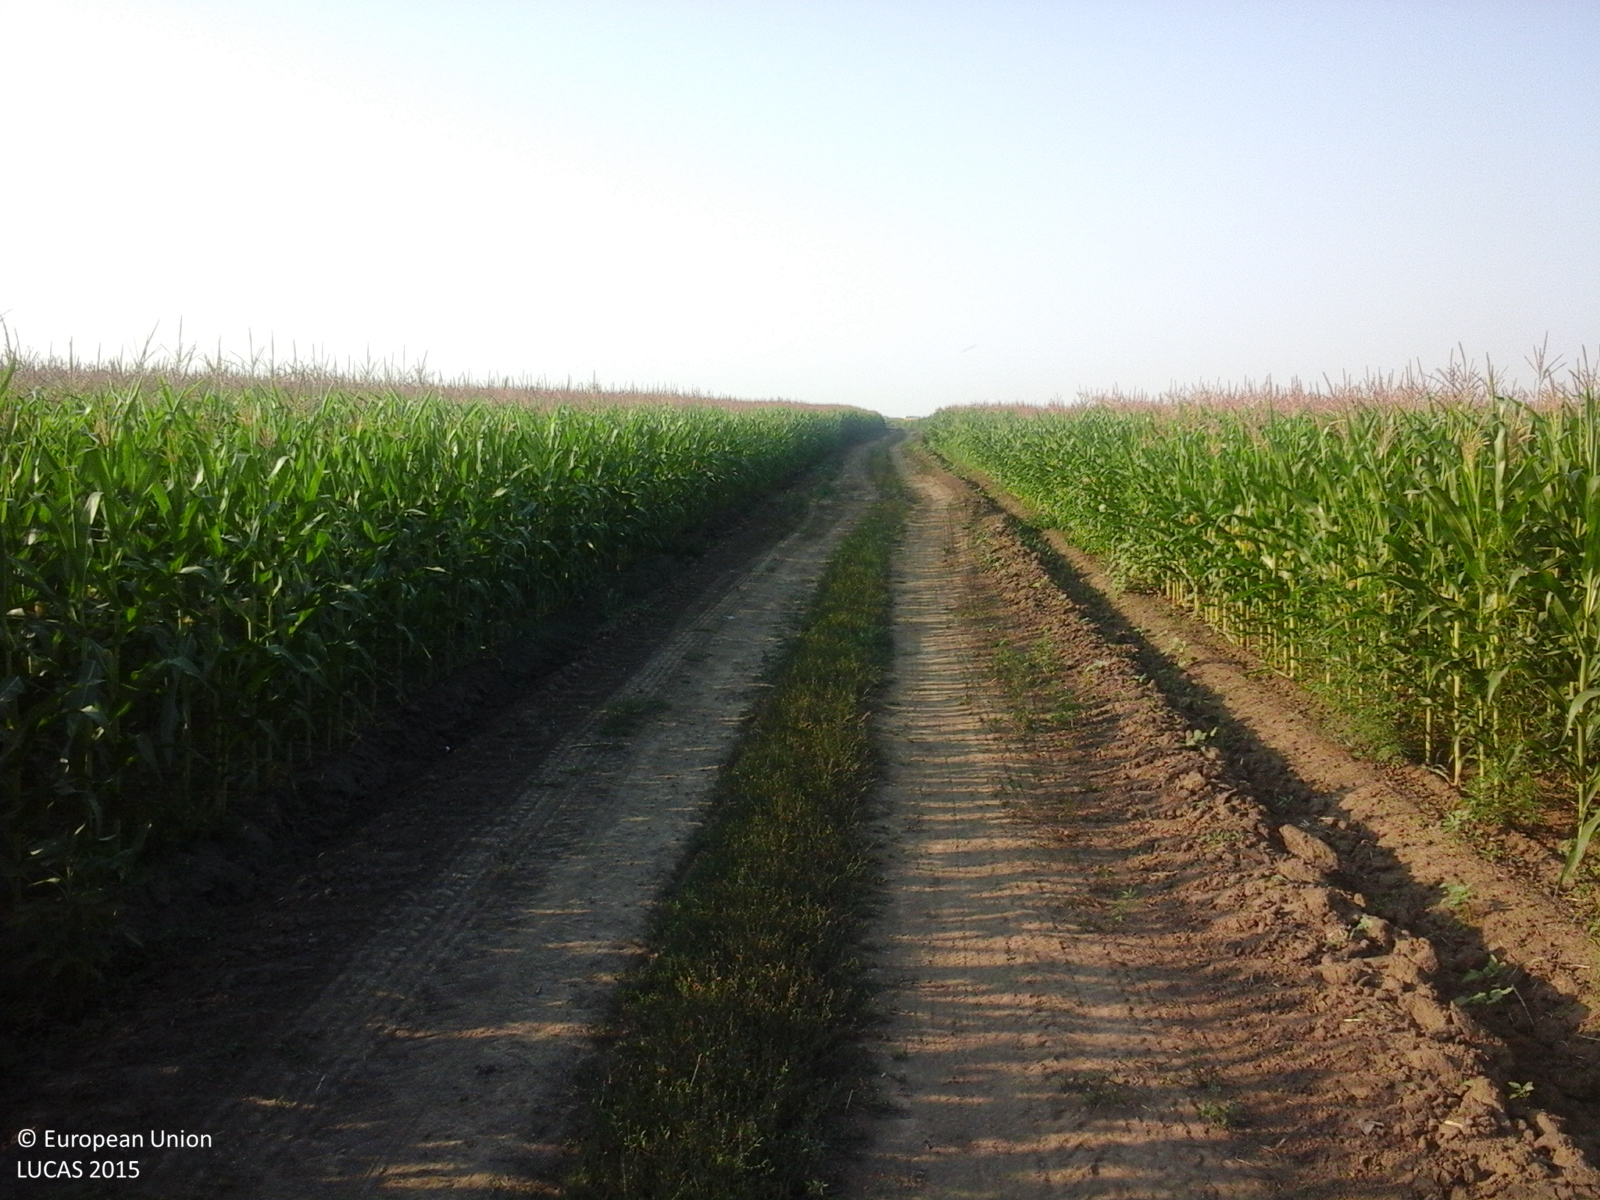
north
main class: Cropland
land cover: Maize
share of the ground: > 75 %
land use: Agriculture (excluding fallow land and kitchen gardens)
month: July
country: RO
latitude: 44.6556
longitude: 27.2760
